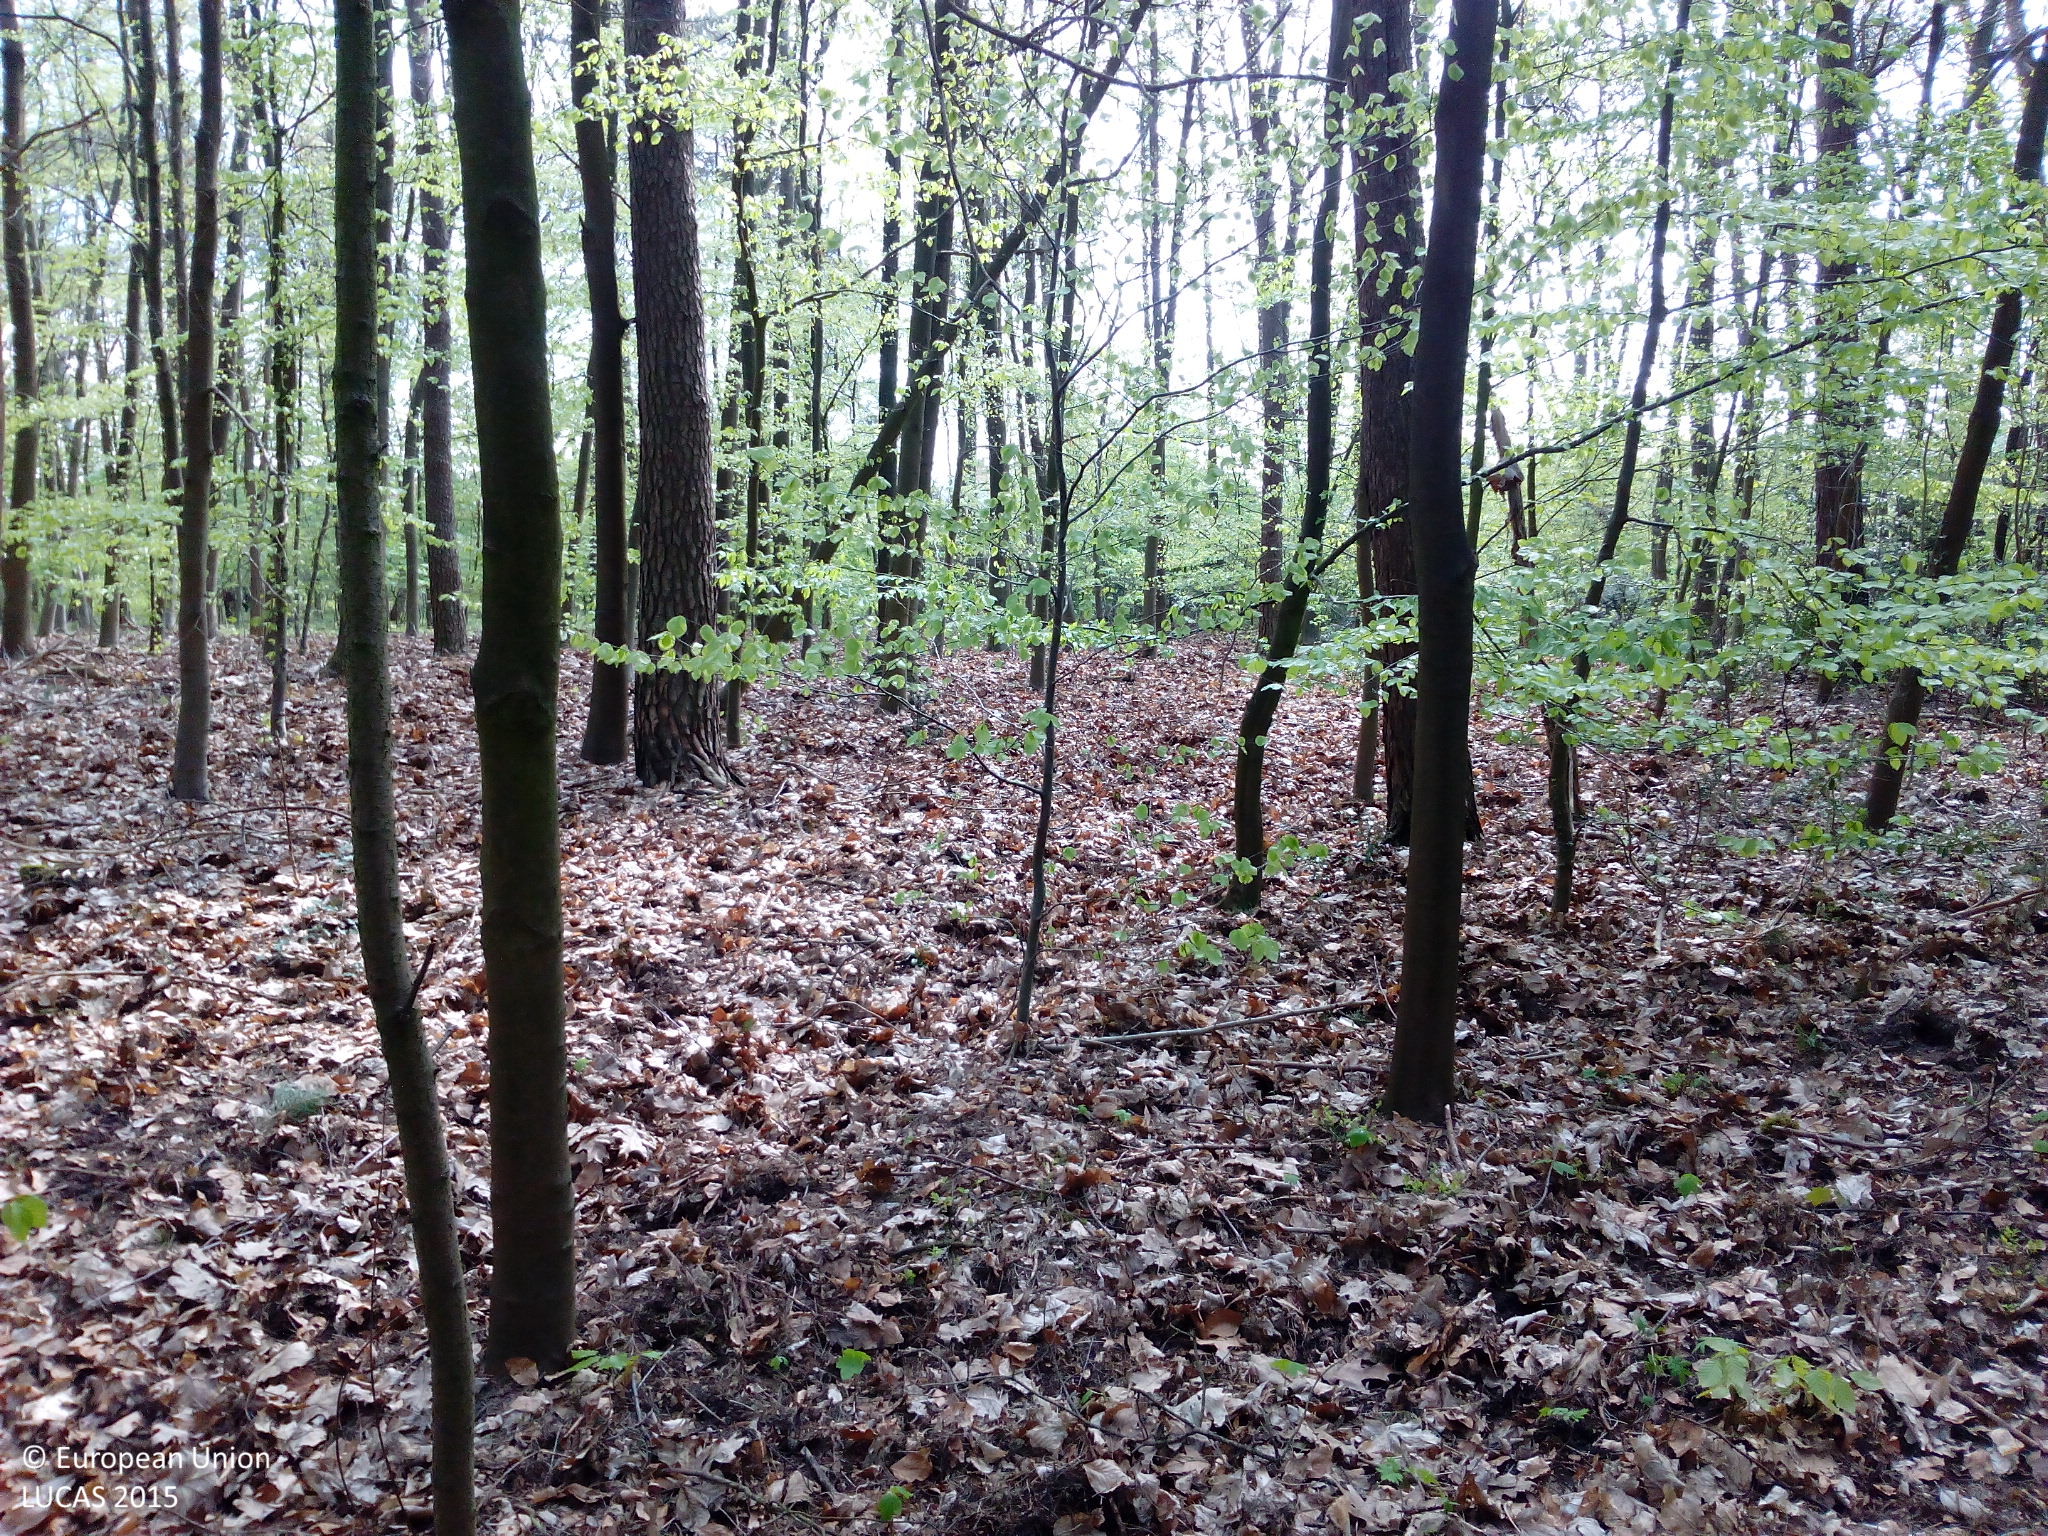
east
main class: Woodland
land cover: Pine dominated mixed woodland
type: hemiboreal forest and nemoral coniferous forest and mixed broadleaved-coniferous forest
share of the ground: > 75 %
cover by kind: coniferous forest trees 65 %, broadleaved forest trees 25 %, herbaceous plants 10 %
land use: Forestry
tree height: > 5 m
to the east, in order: Pine dominated mixed woodland; Artificial constructions in urban areas; Ditches and canals; Artificial constructions in urban areas
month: May
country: DE
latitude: 53.2138
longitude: 8.5780
